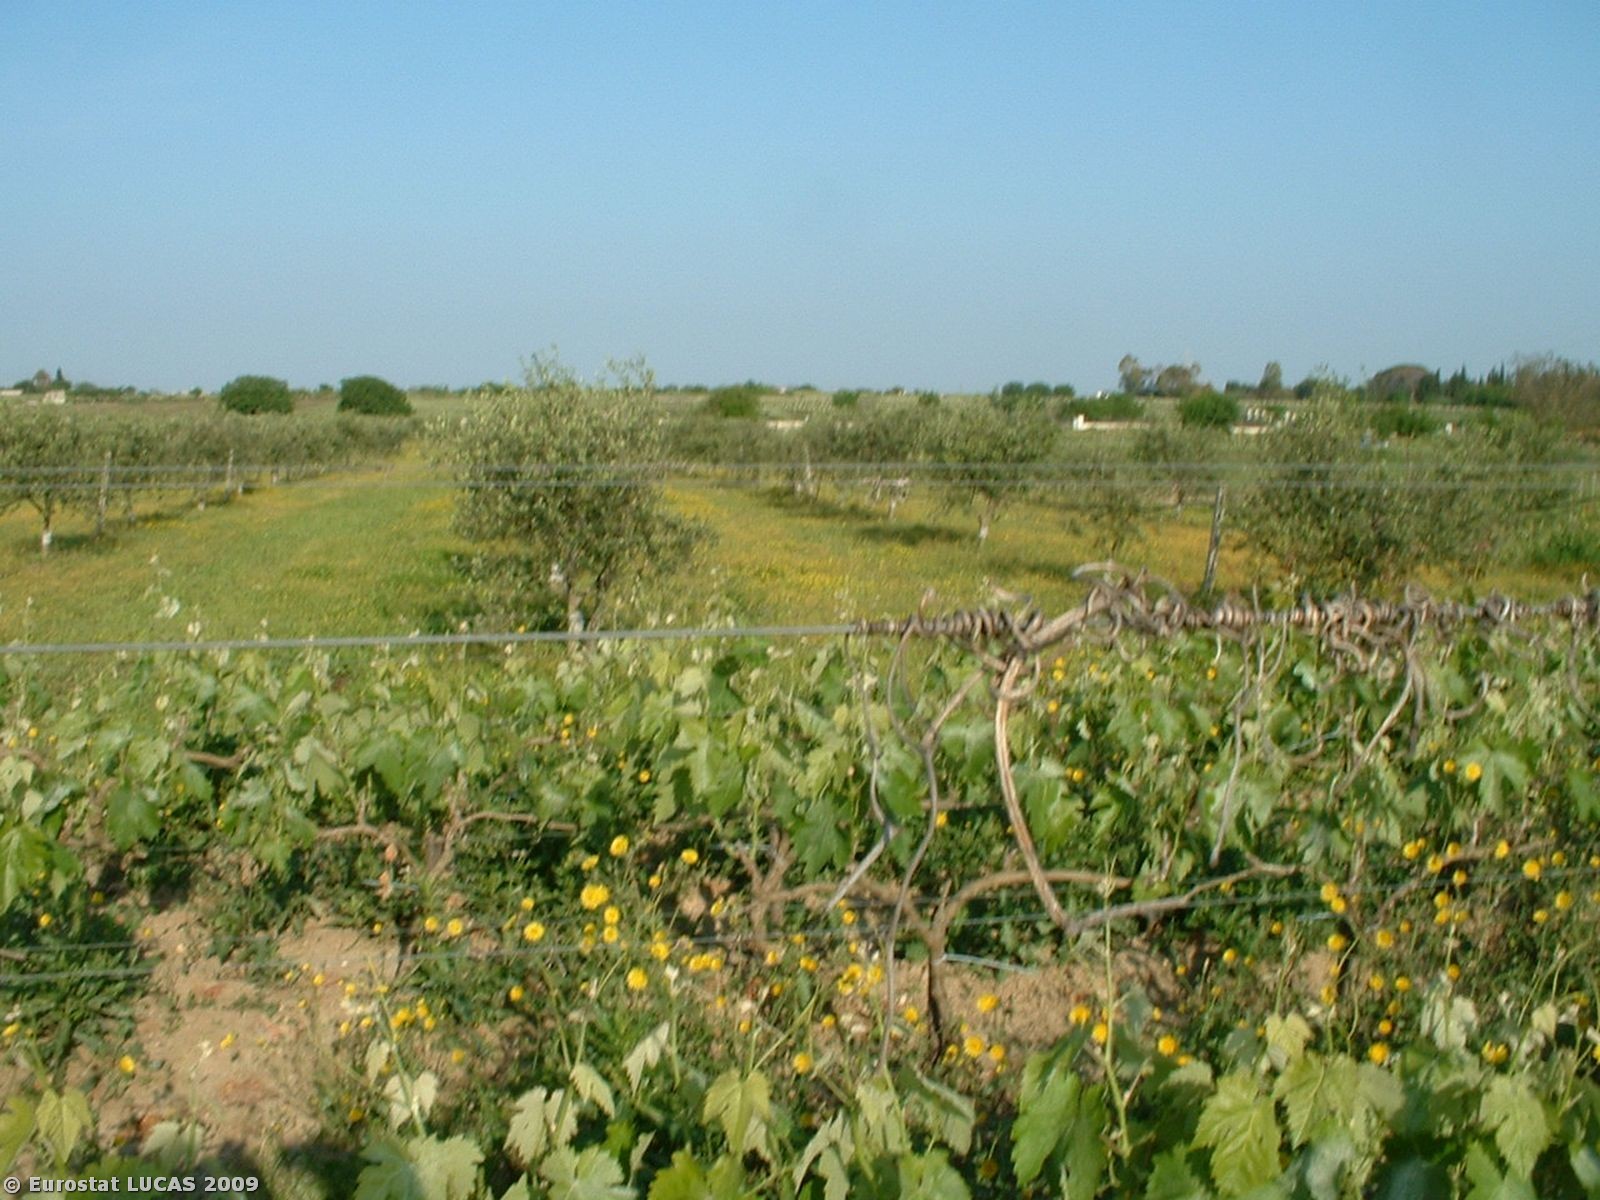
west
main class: Cropland
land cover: Vineyards
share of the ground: 25 - 50 %
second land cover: Bare land
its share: > 75 %
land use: Agriculture (excluding fallow land and kitchen gardens)
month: May
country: IT
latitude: 40.1493
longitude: 18.1089
